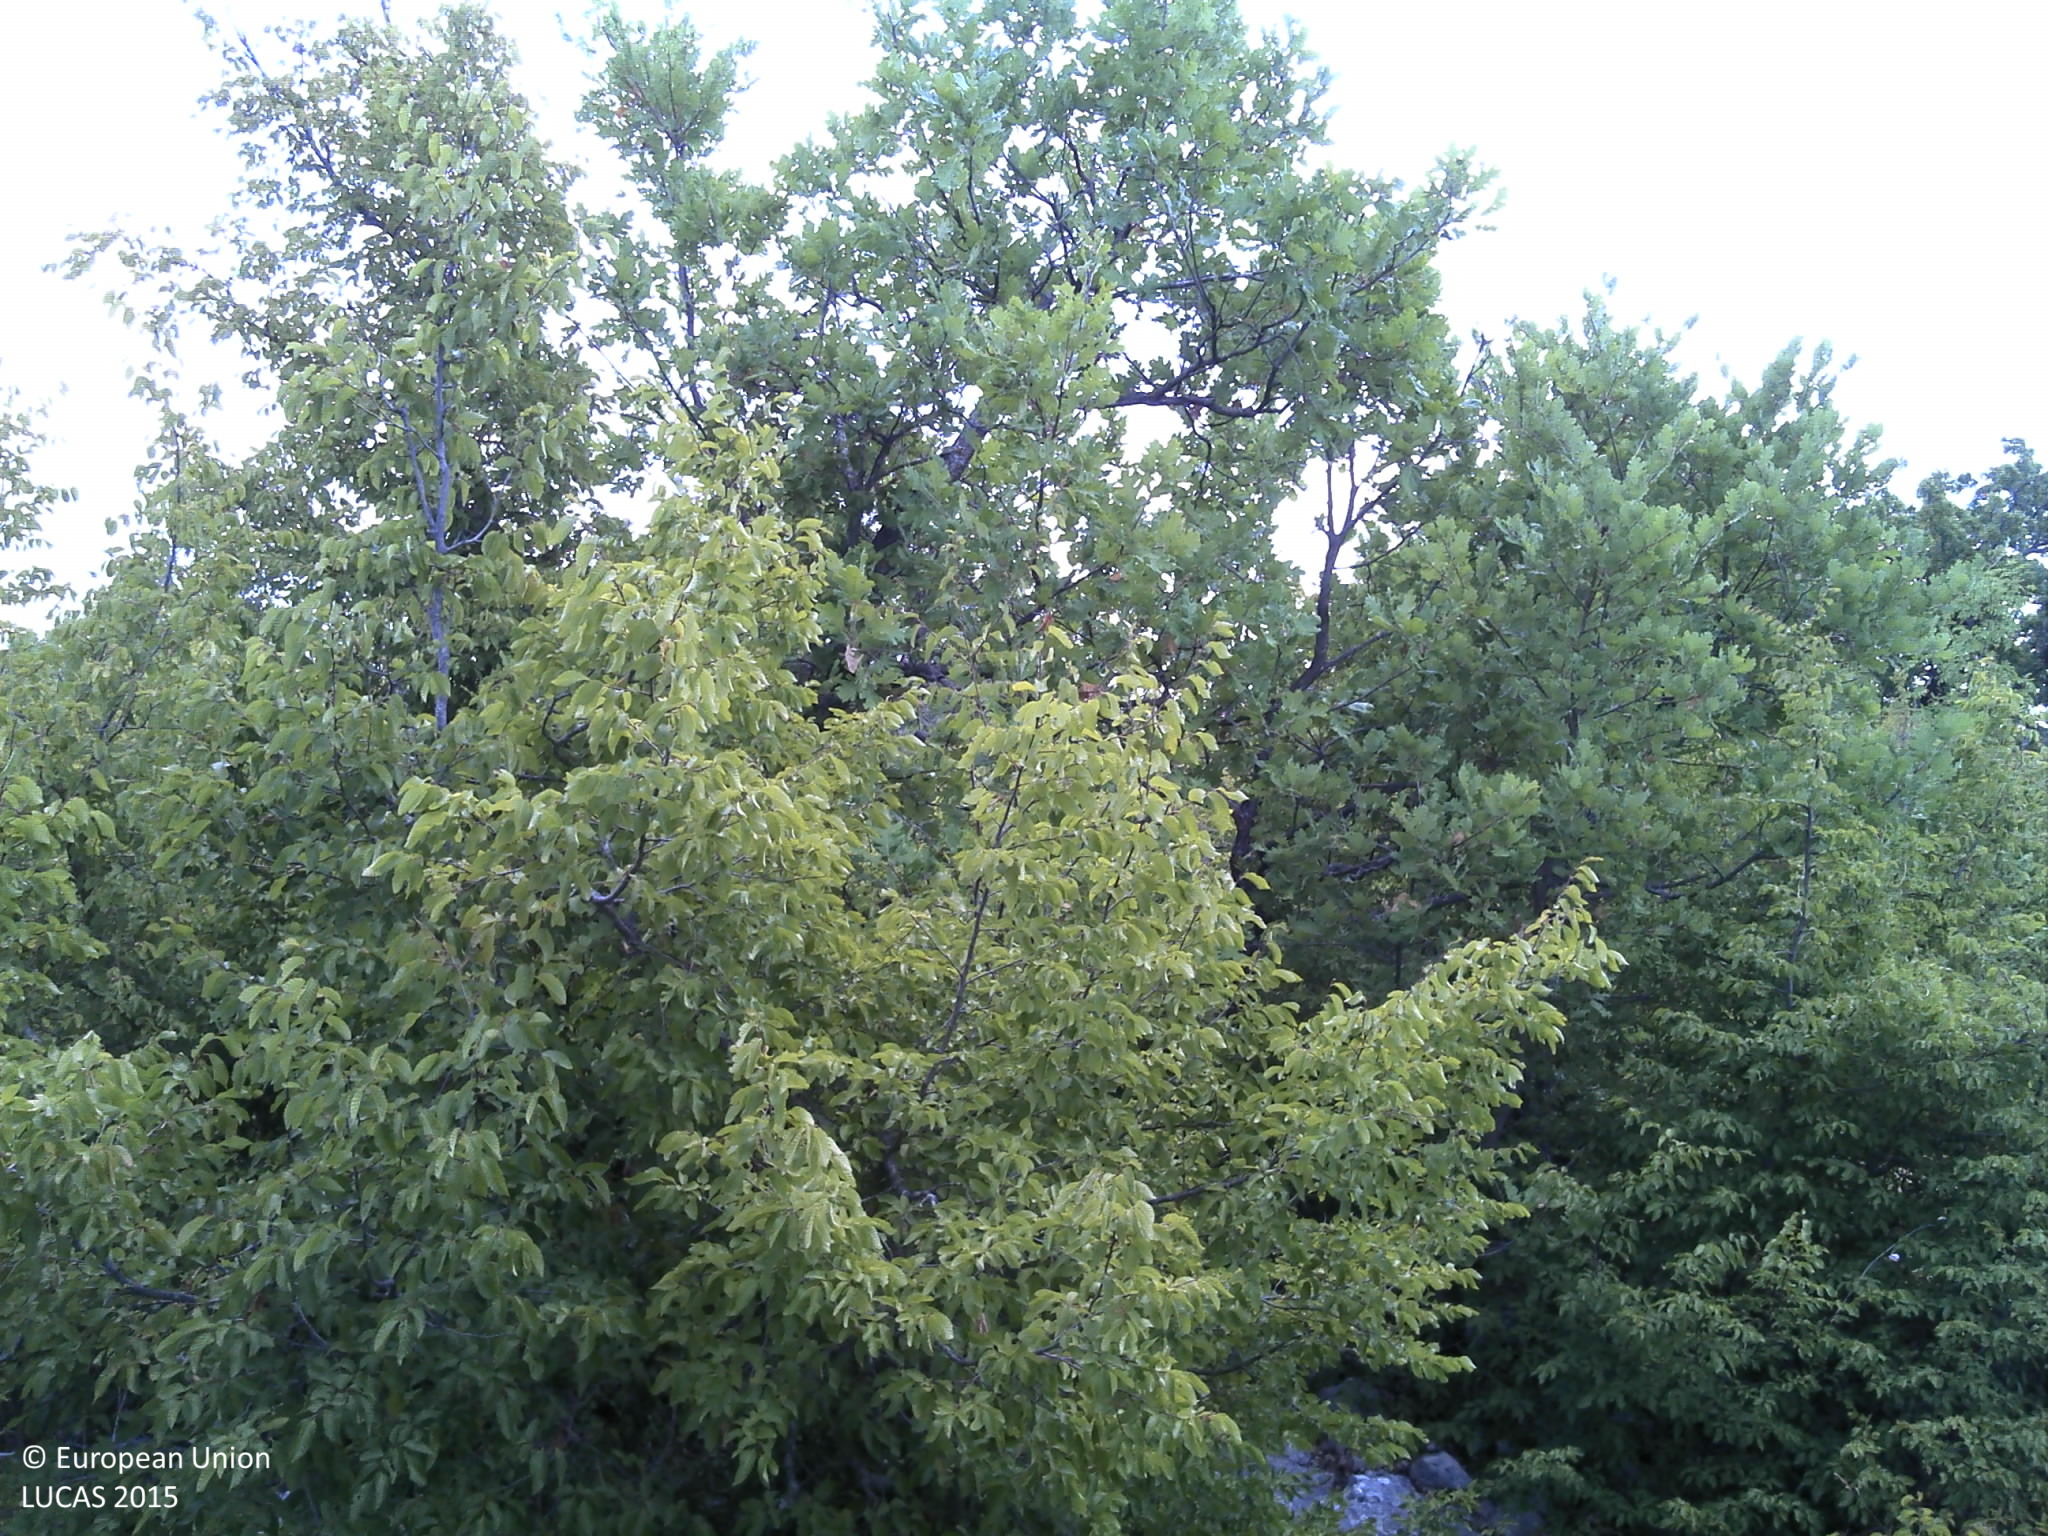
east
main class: Woodland
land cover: Broadleaved woodland
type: thermophilous deciduous forest
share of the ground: 50 - 75 %
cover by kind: broadleaved forest trees 60 %, shrubs 20 %, herbaceous plants 10 %, consolidated bare surface 5 %, unconsolidated bare surface 5 %
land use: Semi-natural and natural areas not in use
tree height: > 5 m
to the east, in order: Broadleaved woodland; Shrubland with sparse tree cover; Broadleaved woodland; Shrubland with sparse tree cover
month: July
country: HR
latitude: 43.7692
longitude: 16.1656
